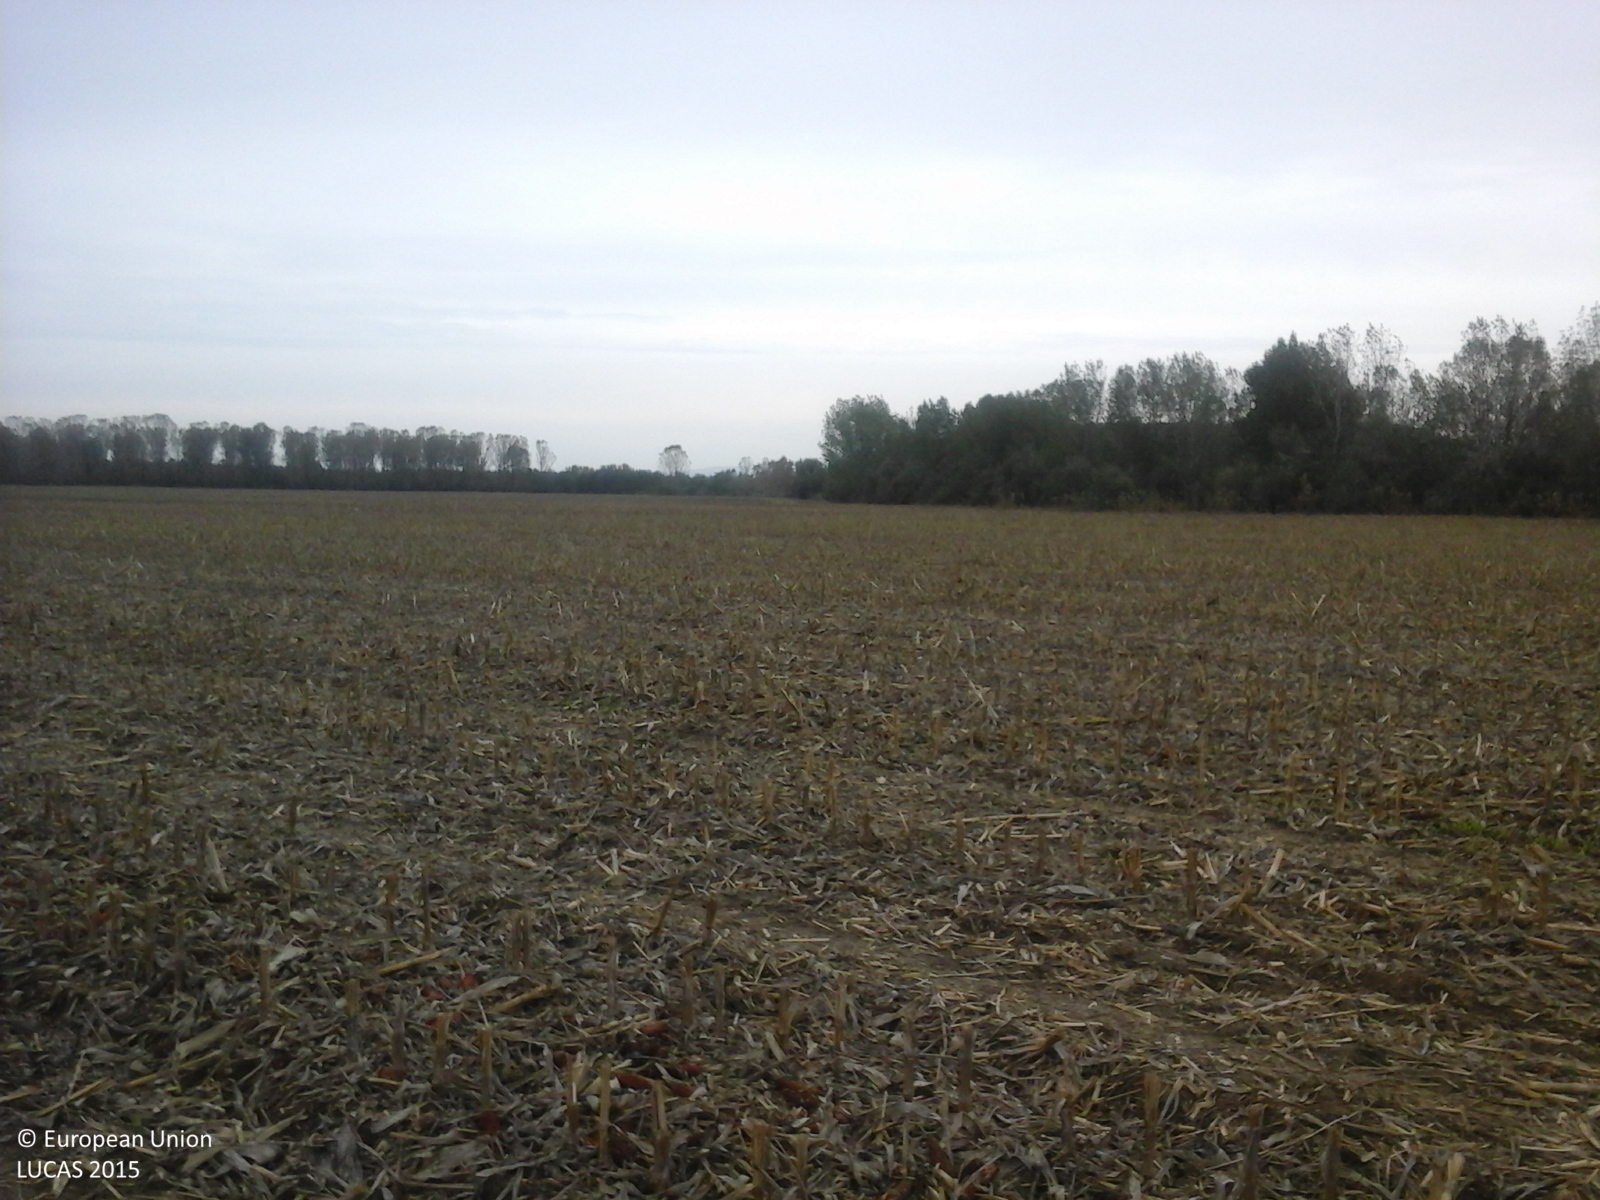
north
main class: Cropland
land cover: Maize
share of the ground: 50 - 75 %
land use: Agriculture (excluding fallow land and kitchen gardens)
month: October
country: RO
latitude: 44.8829
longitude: 26.3329
